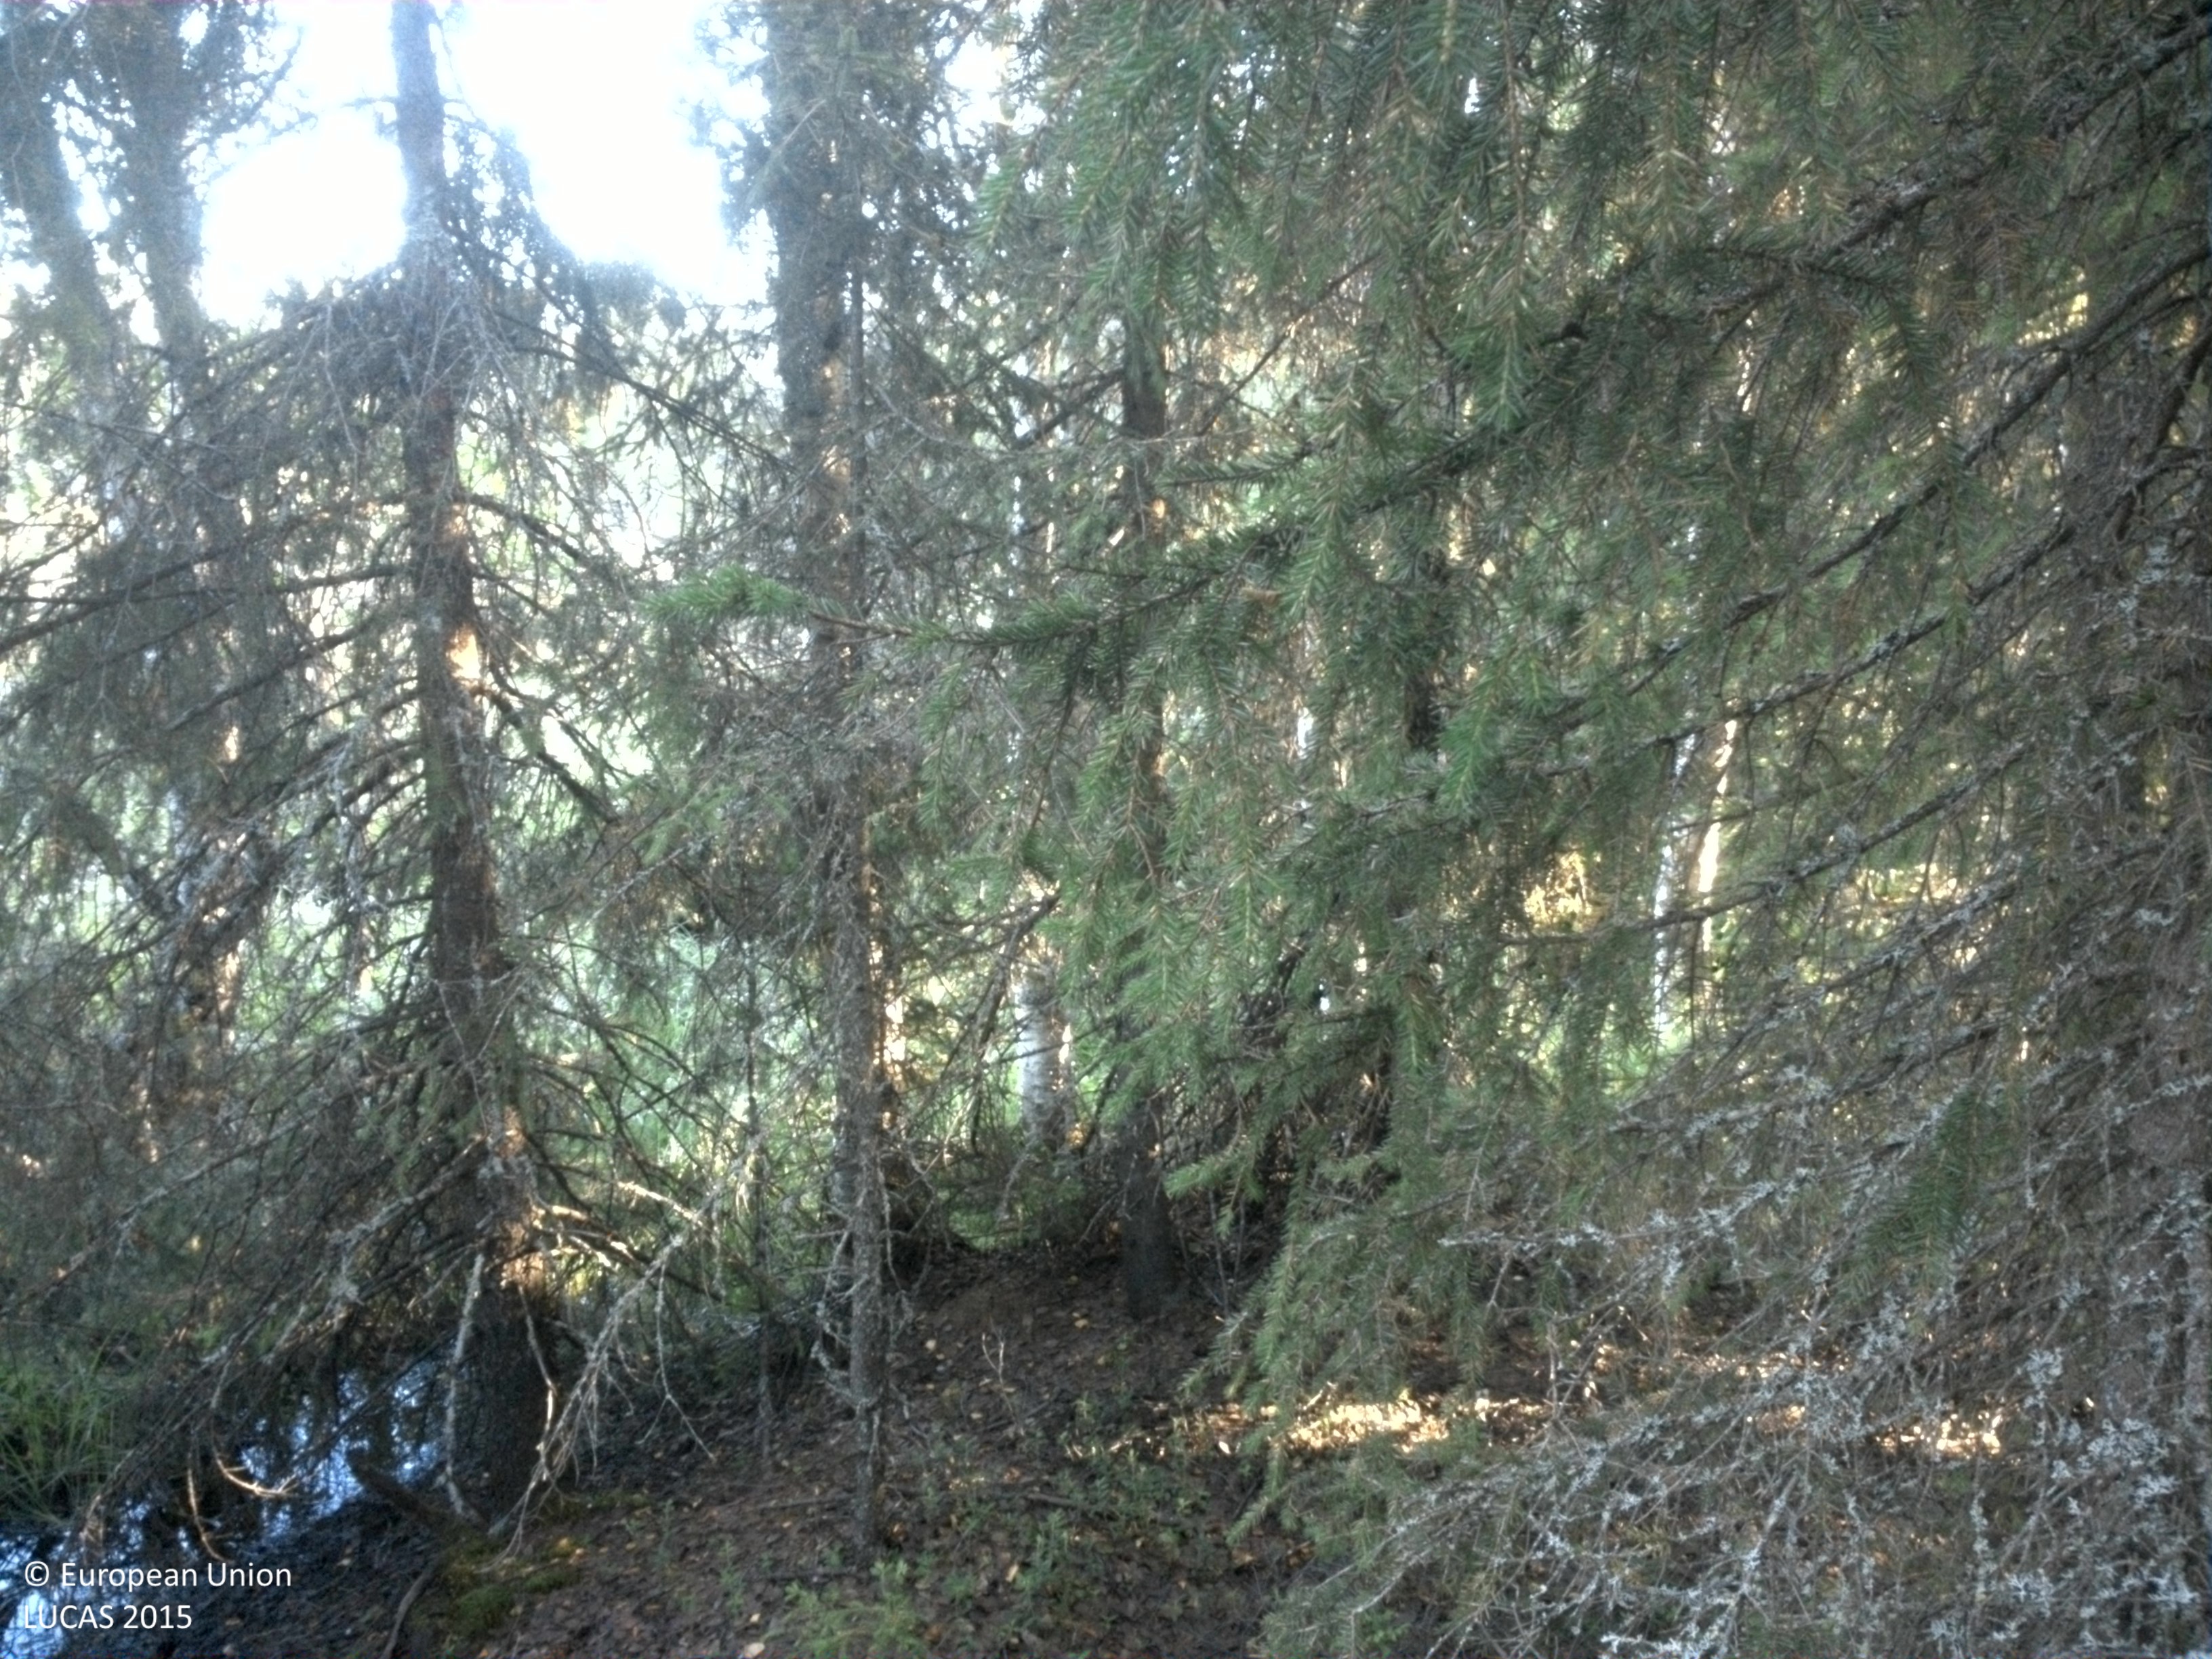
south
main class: Woodland
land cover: Spruce dominated mixed woodland
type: boreal forest
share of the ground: > 75 %
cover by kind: coniferous forest trees 60 %, broadleaved forest trees 20 %, herbaceous plants 20 %
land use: Forestry
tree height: > 5 m
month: August
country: SE
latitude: 64.3931
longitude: 18.4092
